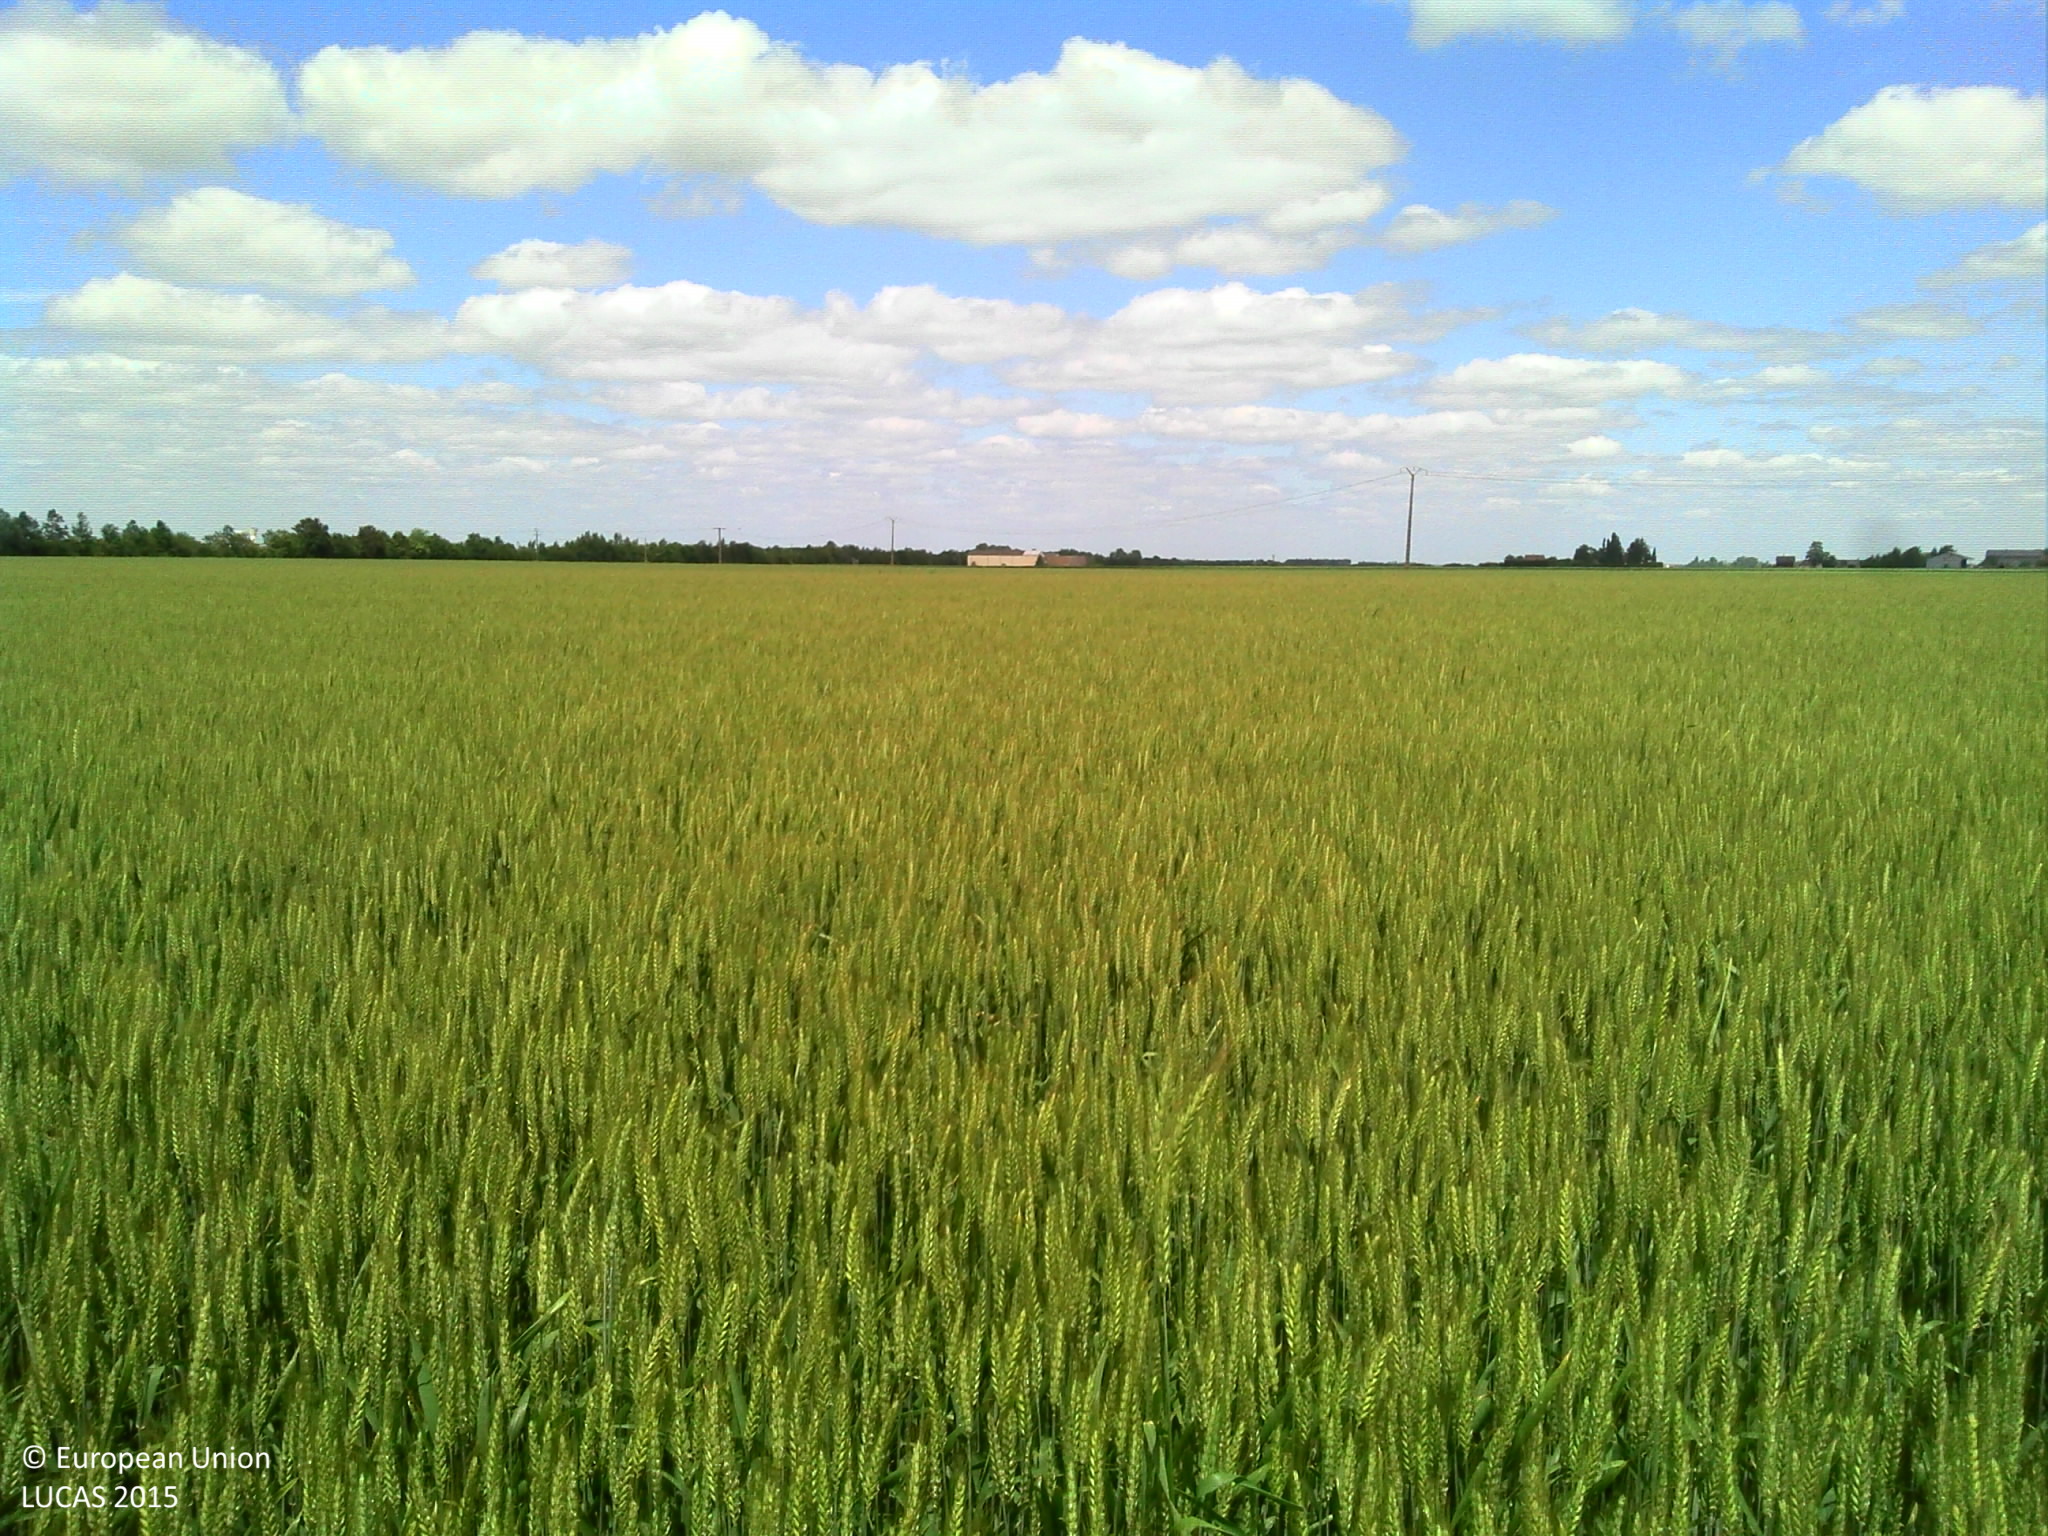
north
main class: Cropland
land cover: Common wheat
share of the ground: > 75 %
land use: Agriculture (excluding fallow land and kitchen gardens)
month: June
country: FR
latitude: 48.3950
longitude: 1.8961
